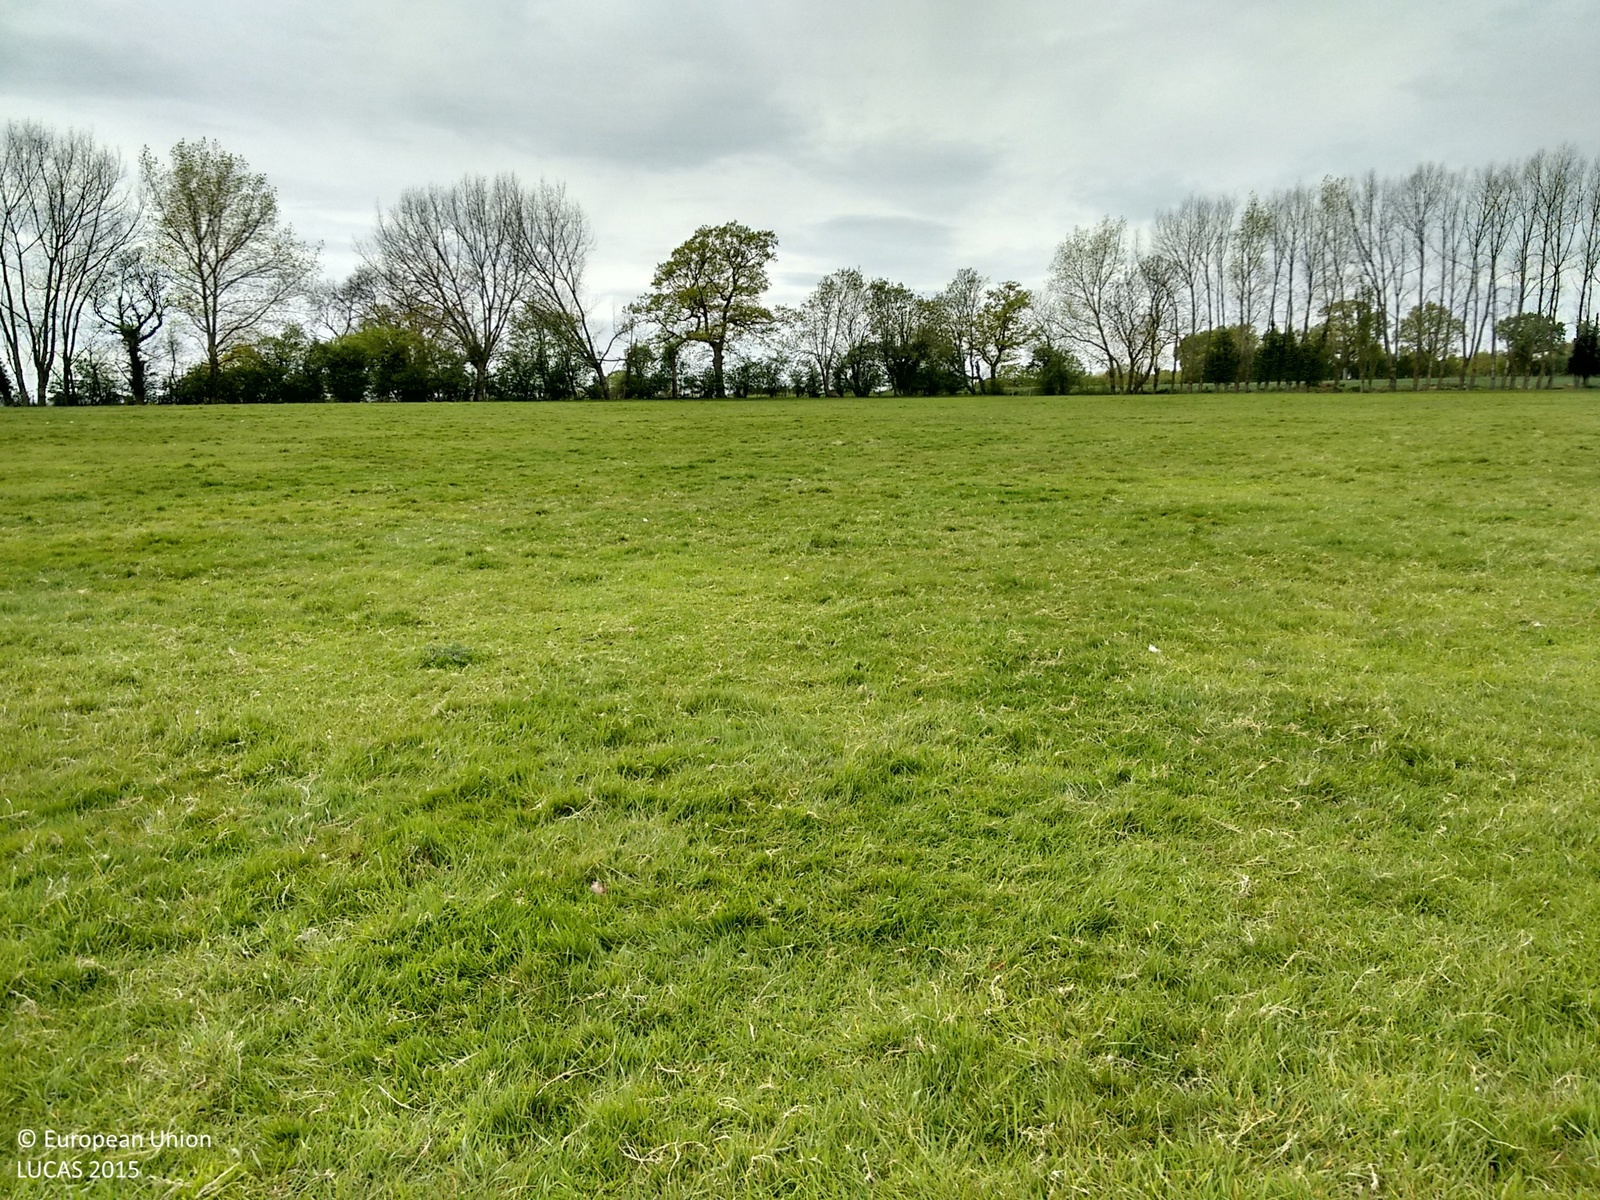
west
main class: Grassland
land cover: Grassland without tree/shrub cover
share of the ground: > 75 %
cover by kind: herbaceous plants 100 %
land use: Agriculture (excluding fallow land and kitchen gardens)
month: May
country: GB
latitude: 51.2047
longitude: 0.5692
